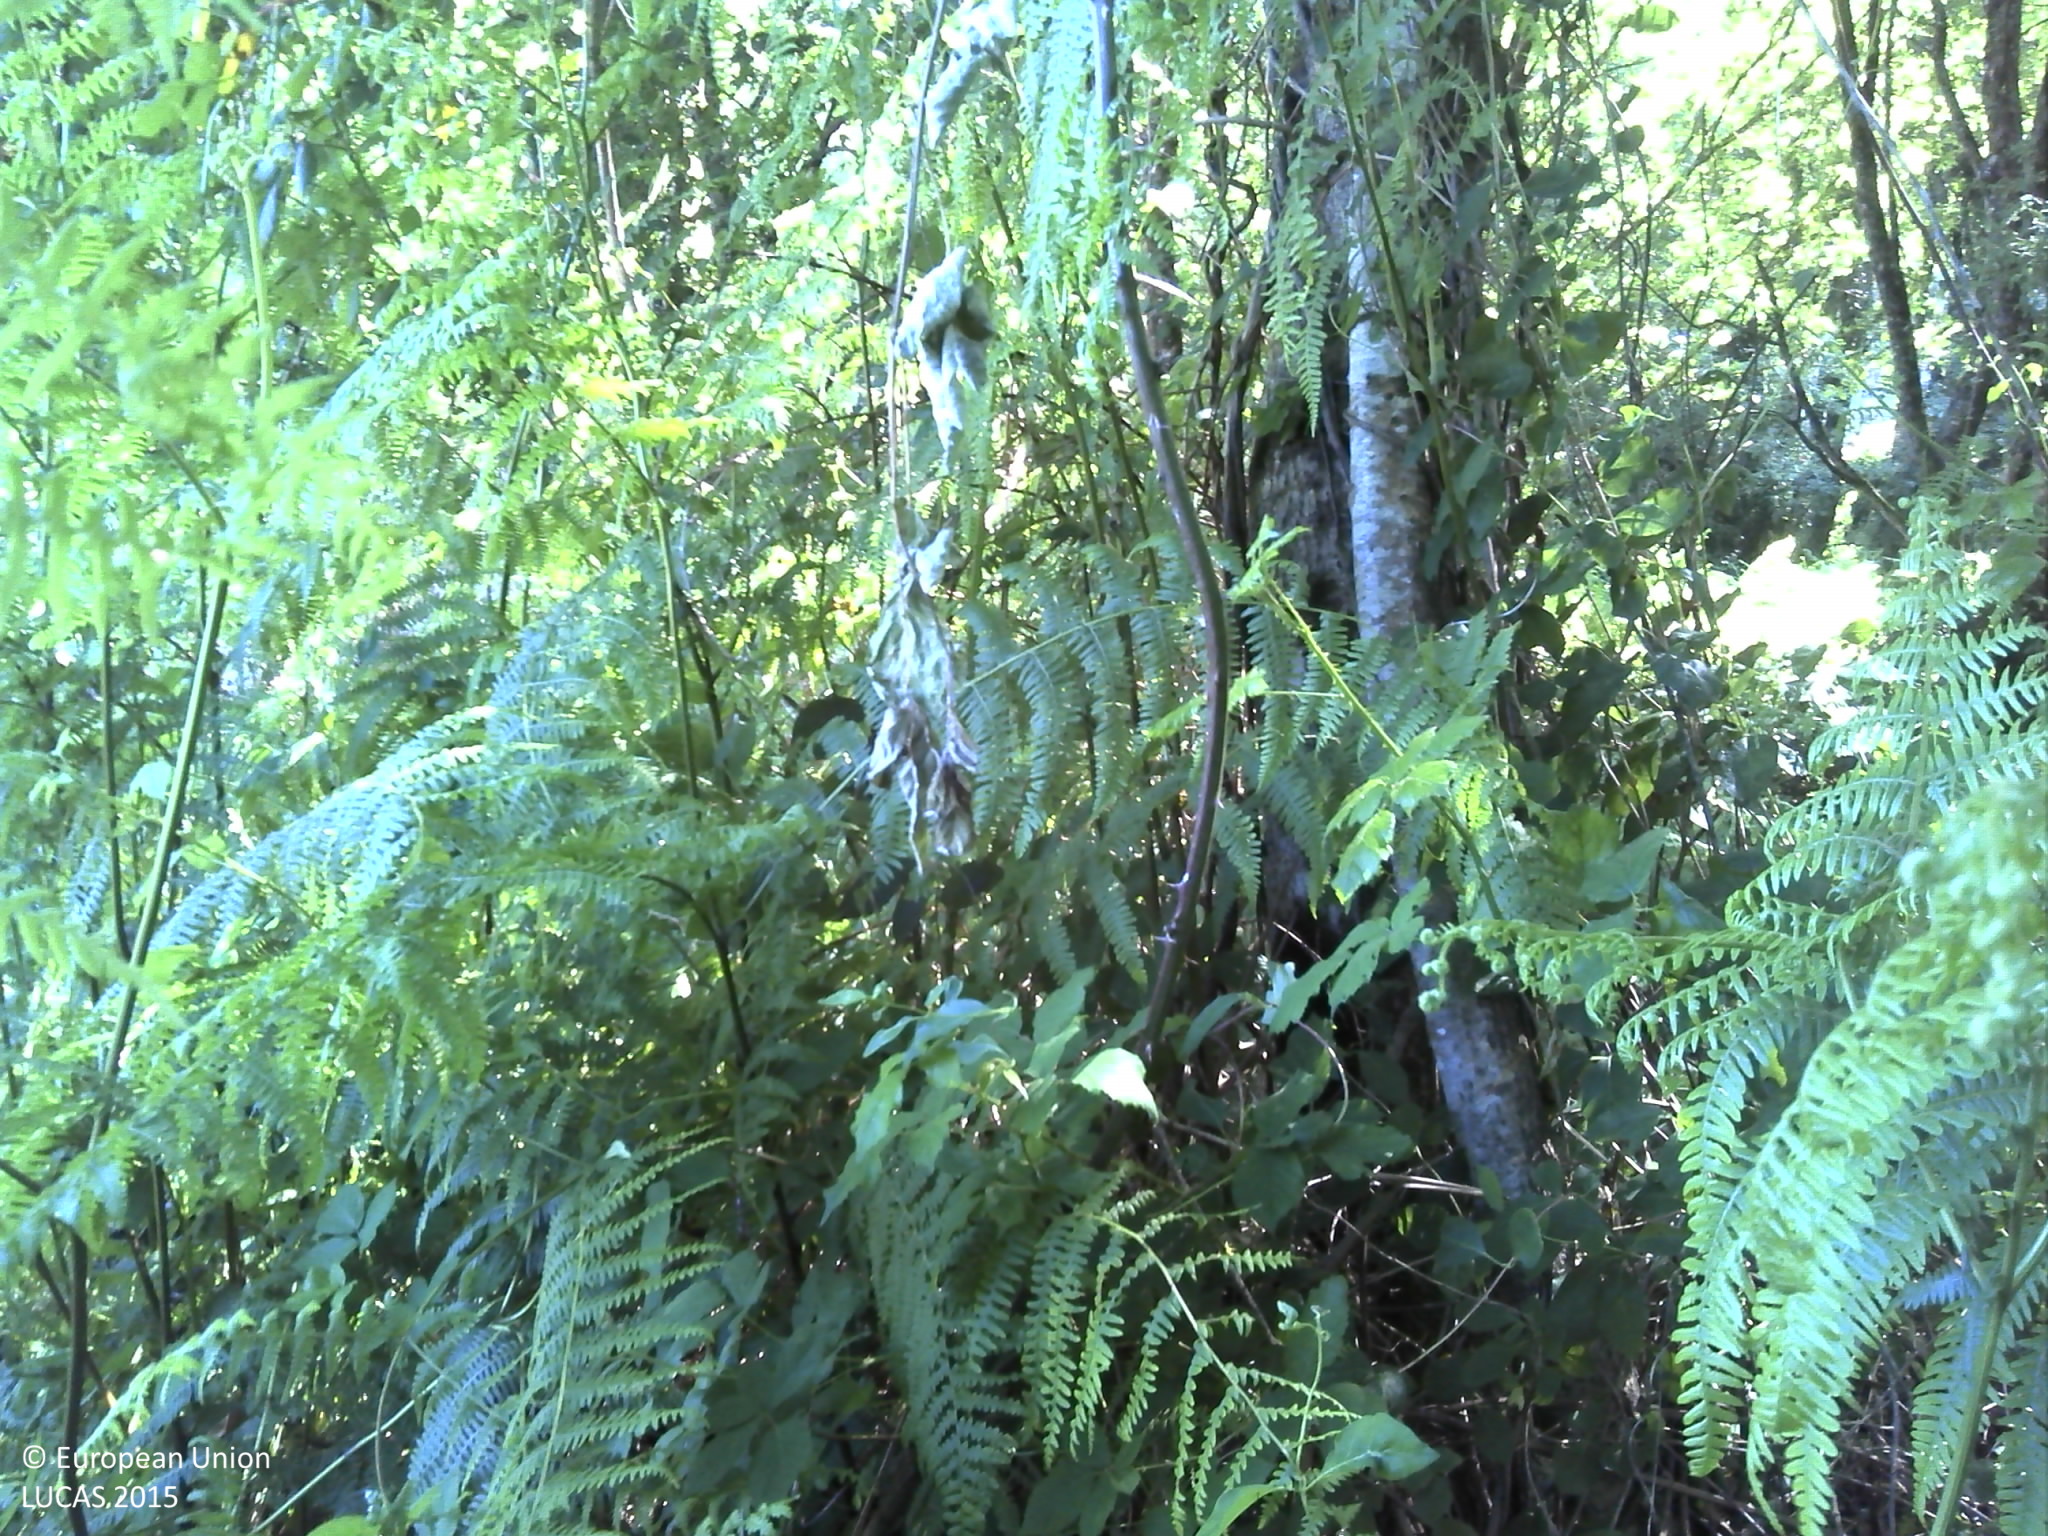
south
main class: Woodland
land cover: Broadleaved woodland
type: thermophilous deciduous forest
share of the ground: > 75 %
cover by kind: broadleaved forest trees 85 %, shrubs 15 %
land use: Forestry
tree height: > 5 m
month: May
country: PT
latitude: 41.9505
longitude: -8.6857
